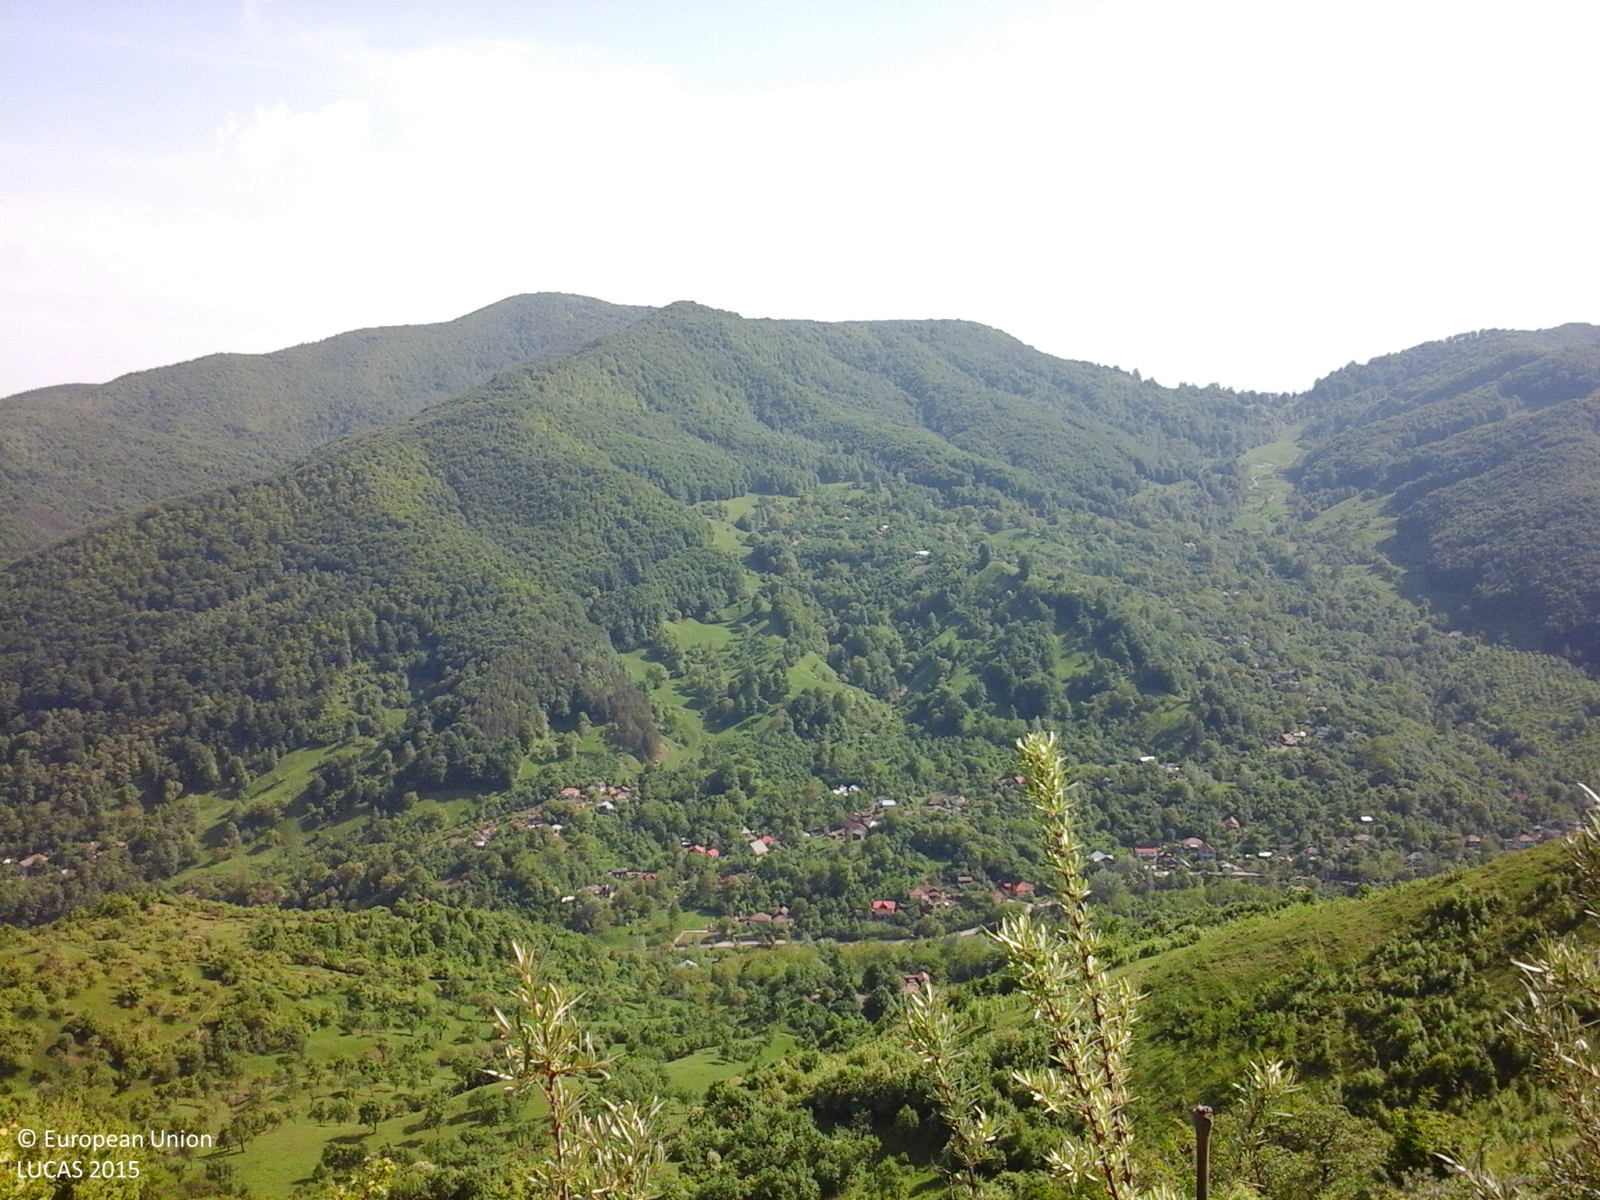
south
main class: Shrubland
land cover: Shrubland with sparse tree cover
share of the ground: > 75 %
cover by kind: shrubs 95 %, broadleaved forest trees 5 %
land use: Forestry
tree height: < 5 m
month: May
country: RO
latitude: 45.4228
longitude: 26.2862
